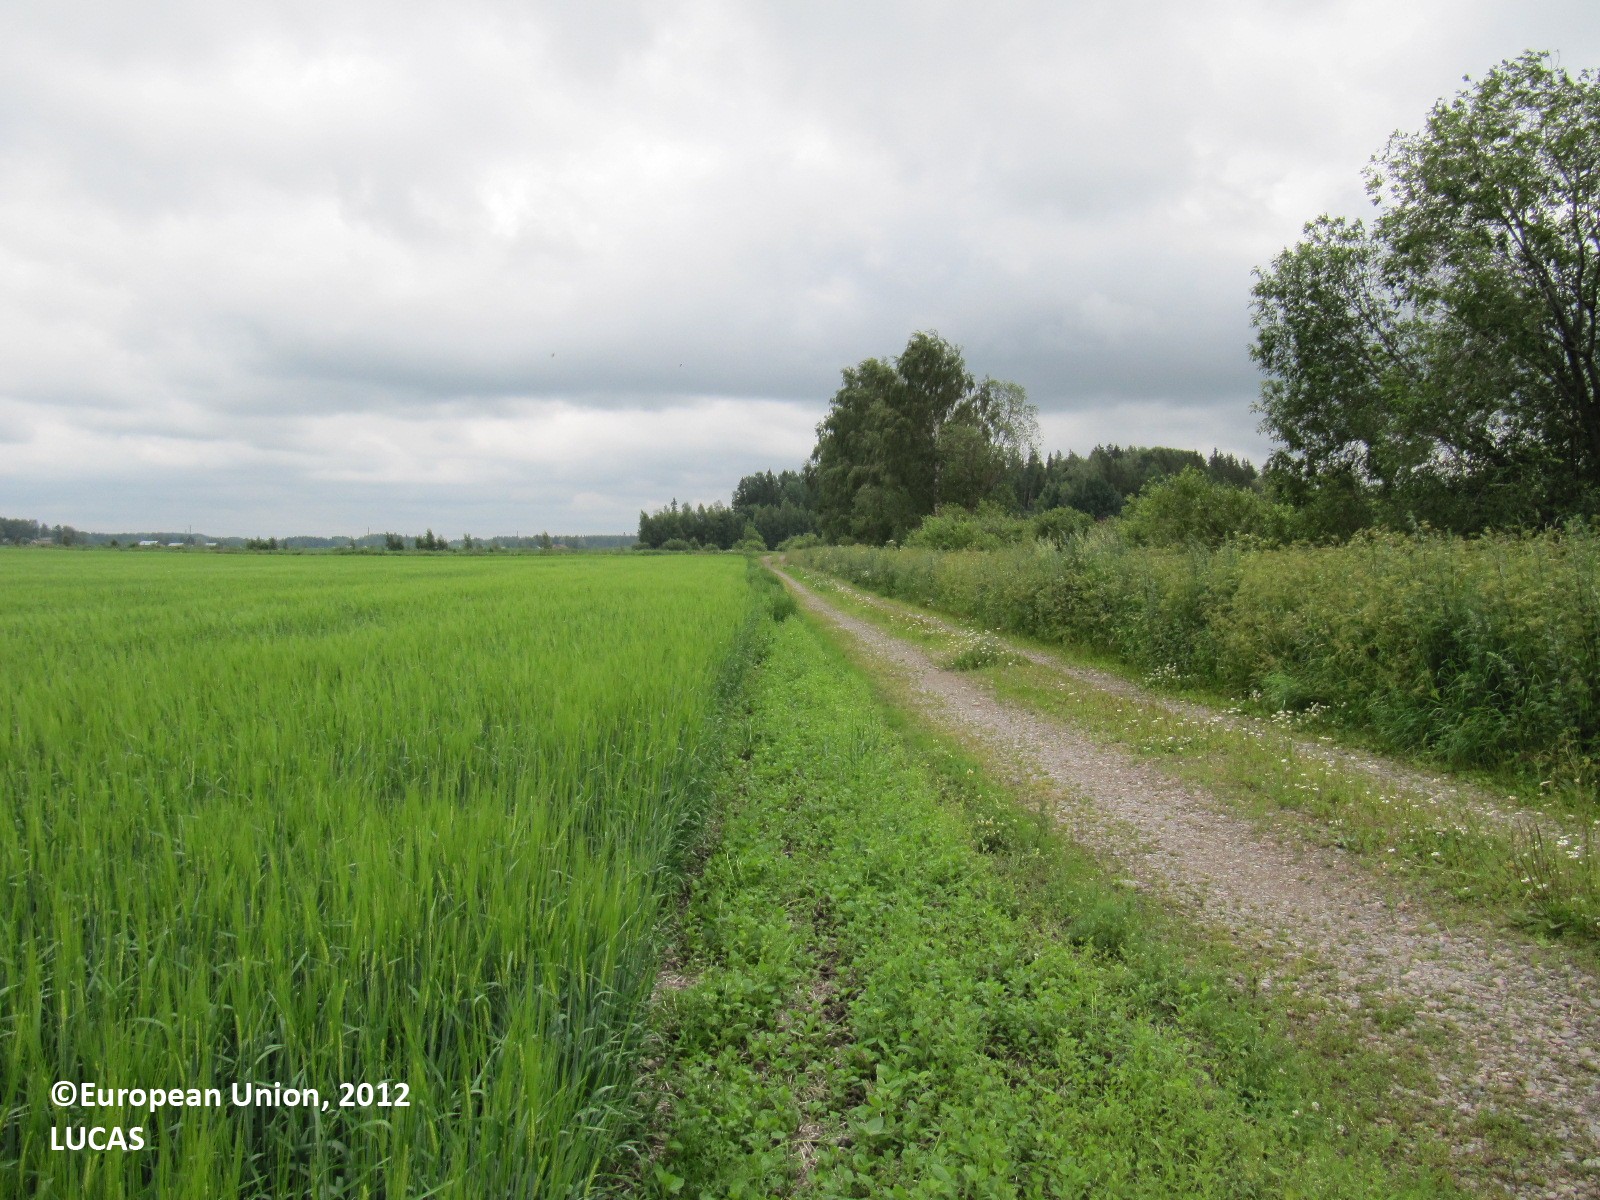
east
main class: Cropland
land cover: Barley
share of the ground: > 75 %
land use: Agriculture (excluding fallow land and kitchen gardens)
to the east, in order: Barley; Spontaneously vegetated surfaces; Tracks; Spontaneously vegetated surfaces; Oats
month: July
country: FI
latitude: 60.9192
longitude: 23.3047
